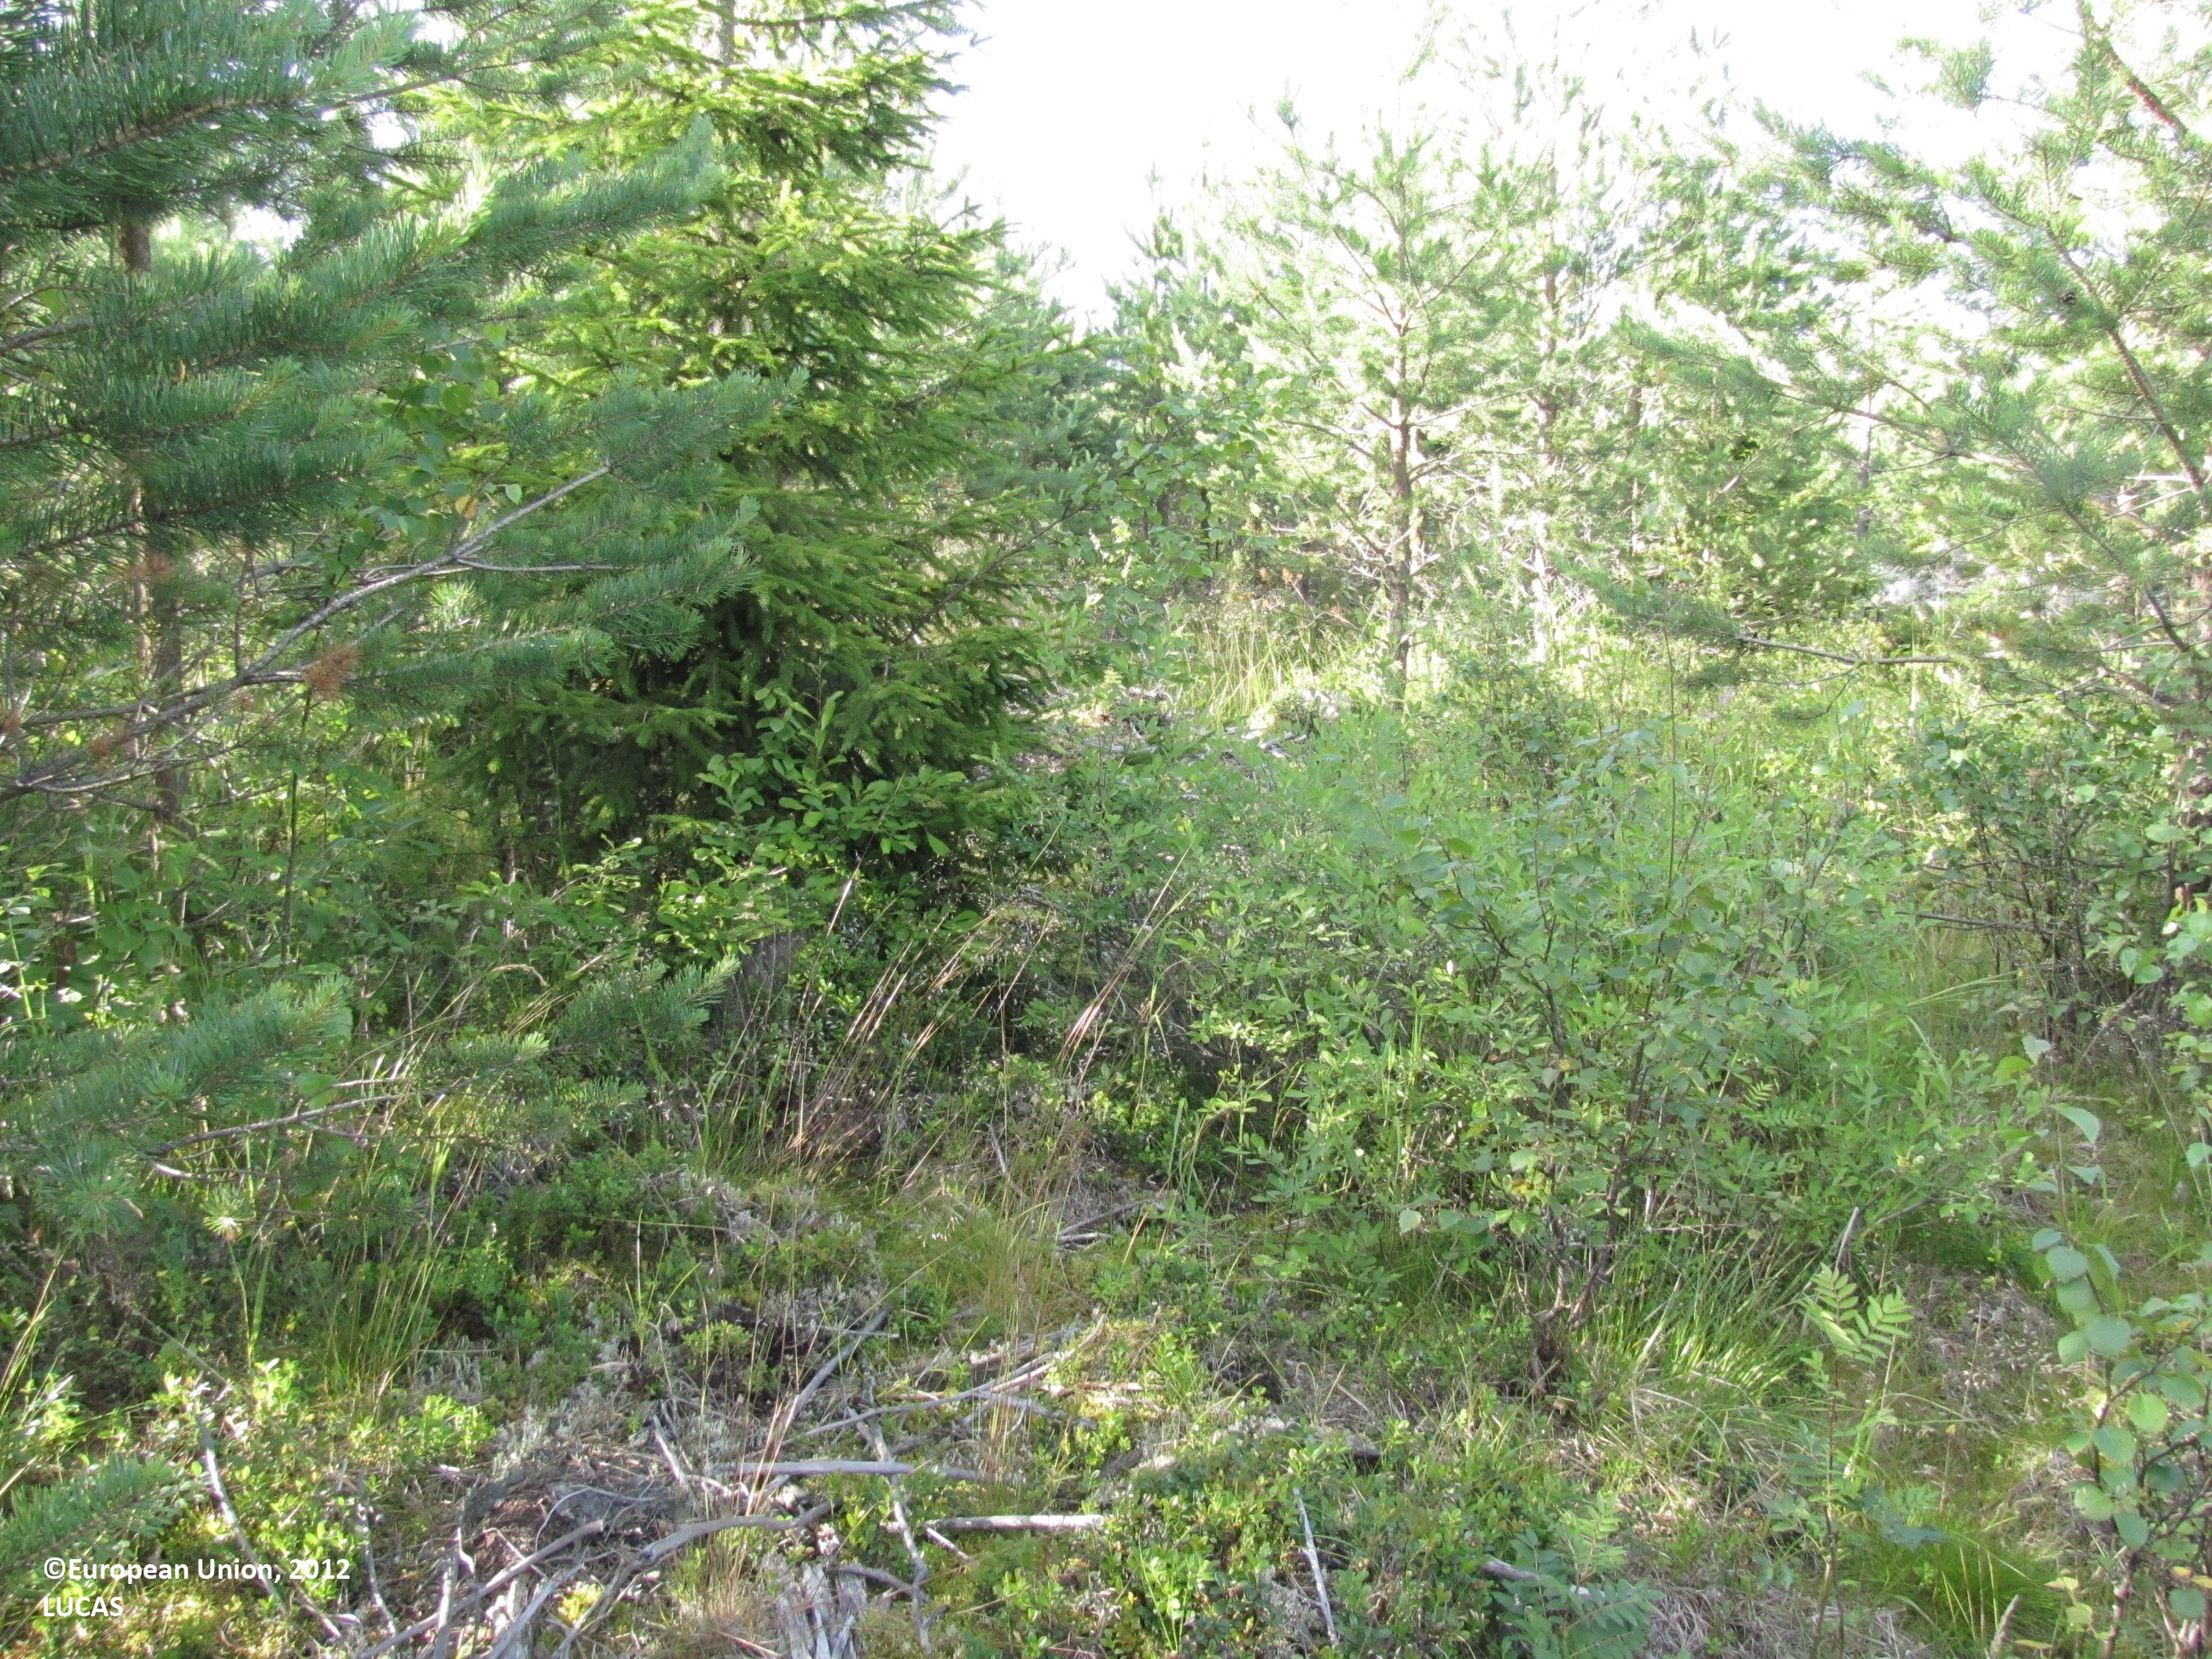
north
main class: Woodland
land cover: Pine dominated mixed woodland
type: boreal forest
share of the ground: > 75 %
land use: Forestry
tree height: < 5 m
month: July
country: FI
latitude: 62.3128
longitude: 23.0879
